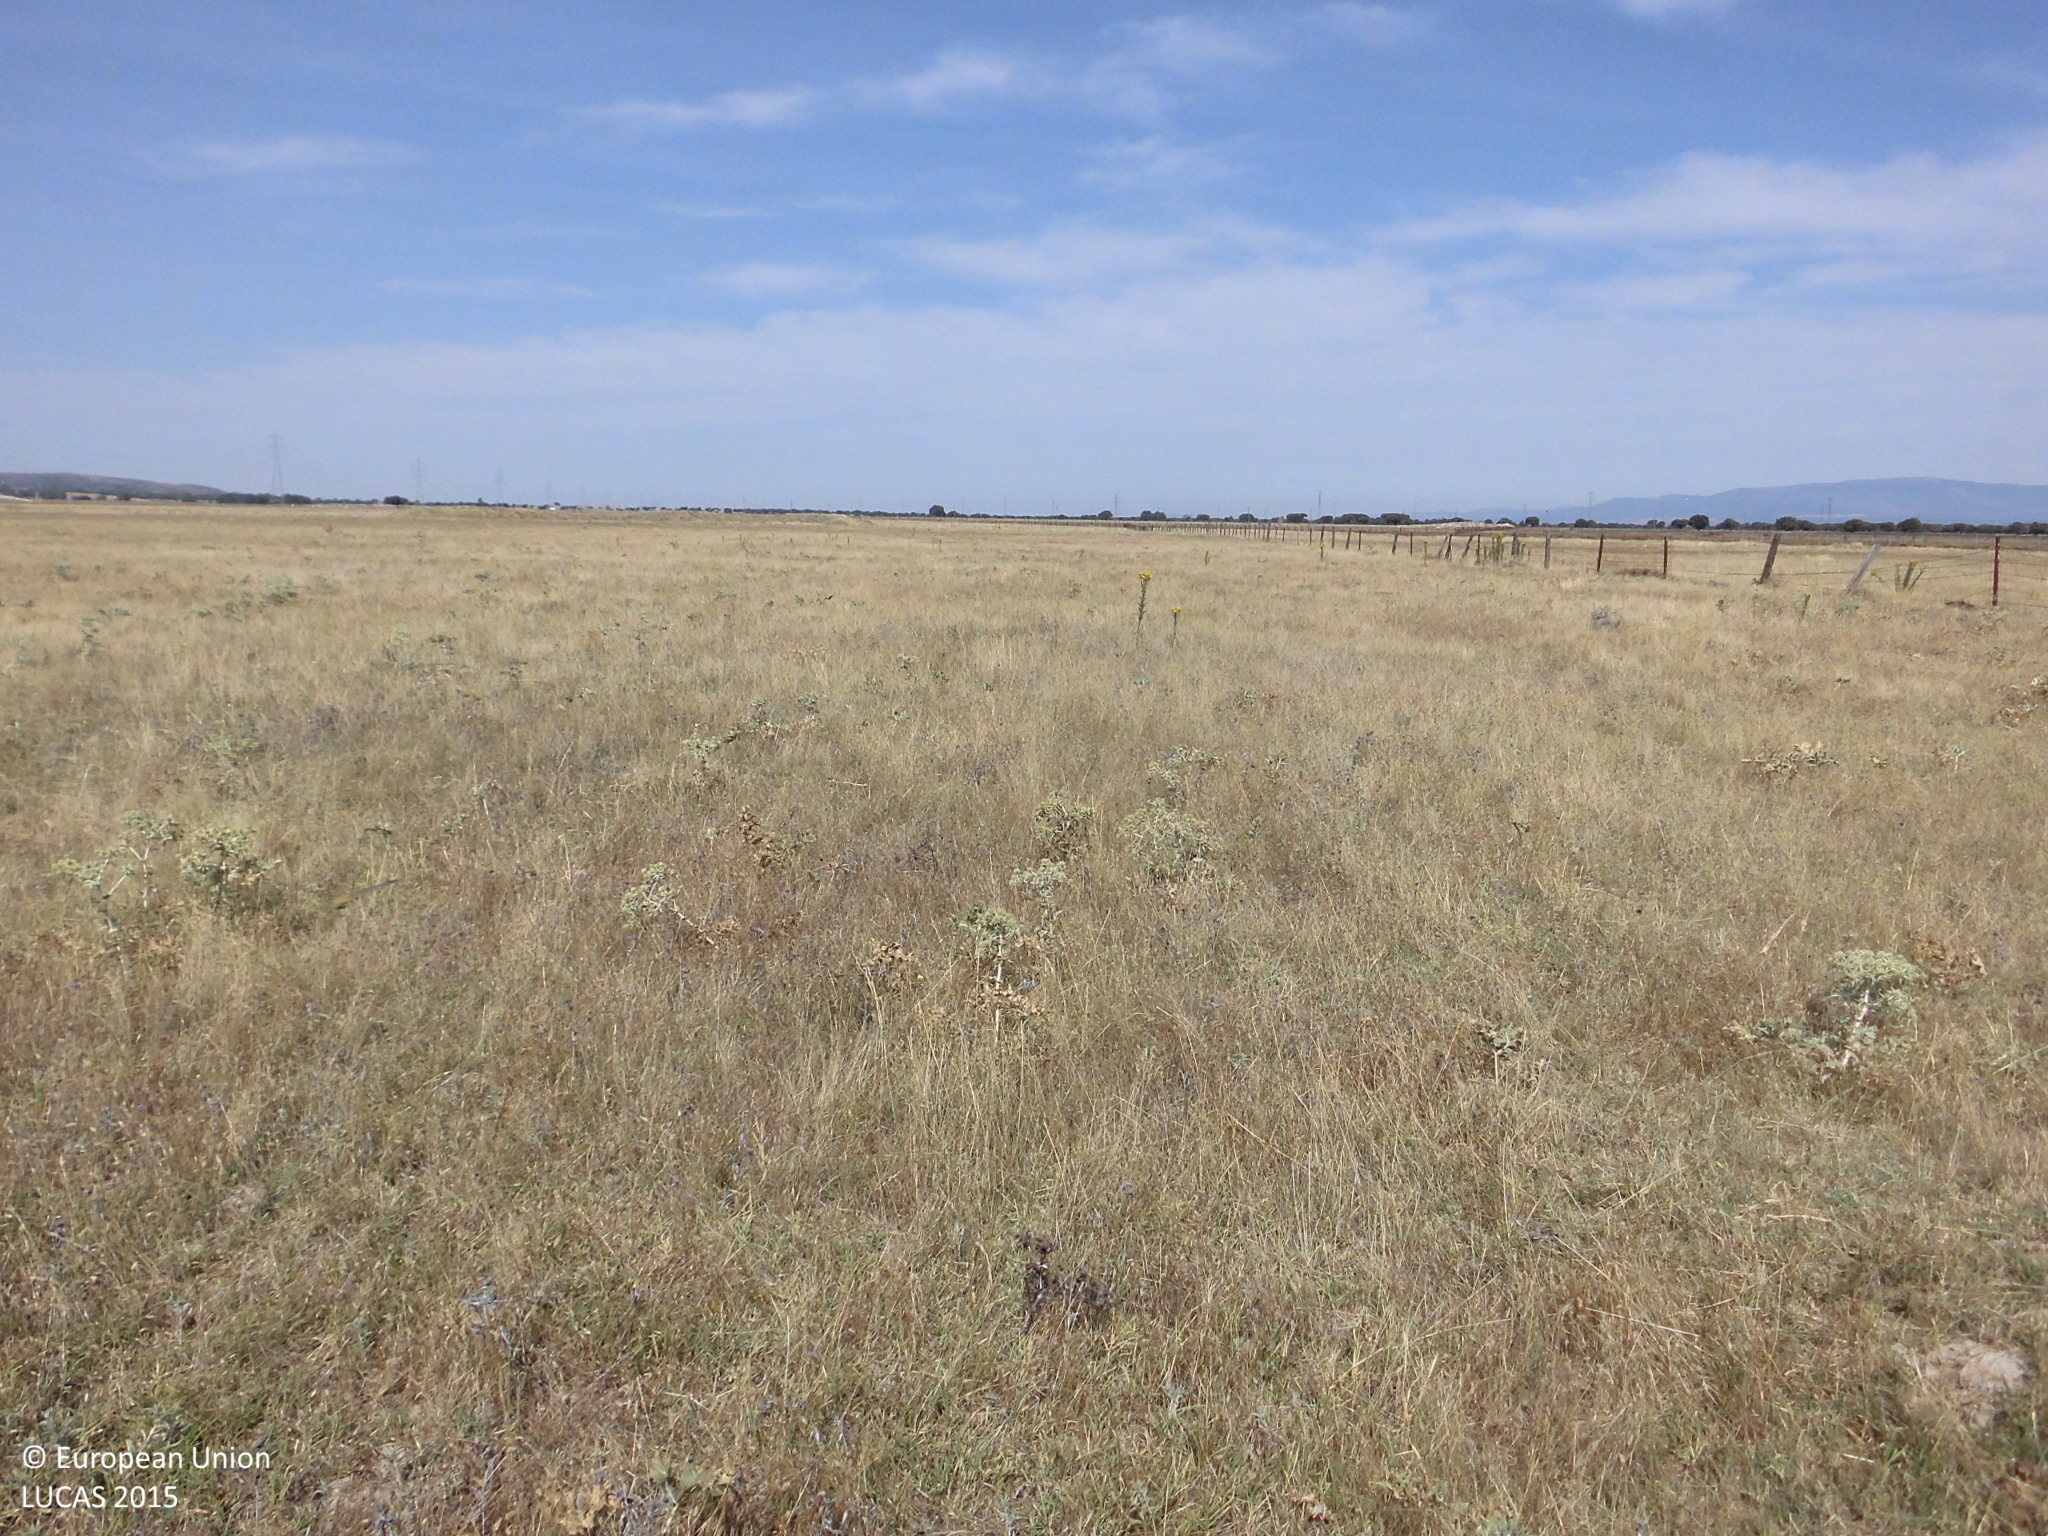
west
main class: Grassland
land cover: Grassland without tree/shrub cover
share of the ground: > 75 %
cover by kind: herbaceous plants 100 %
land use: Agriculture (excluding fallow land and kitchen gardens)
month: July
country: ES
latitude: 39.9151
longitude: -5.4652
